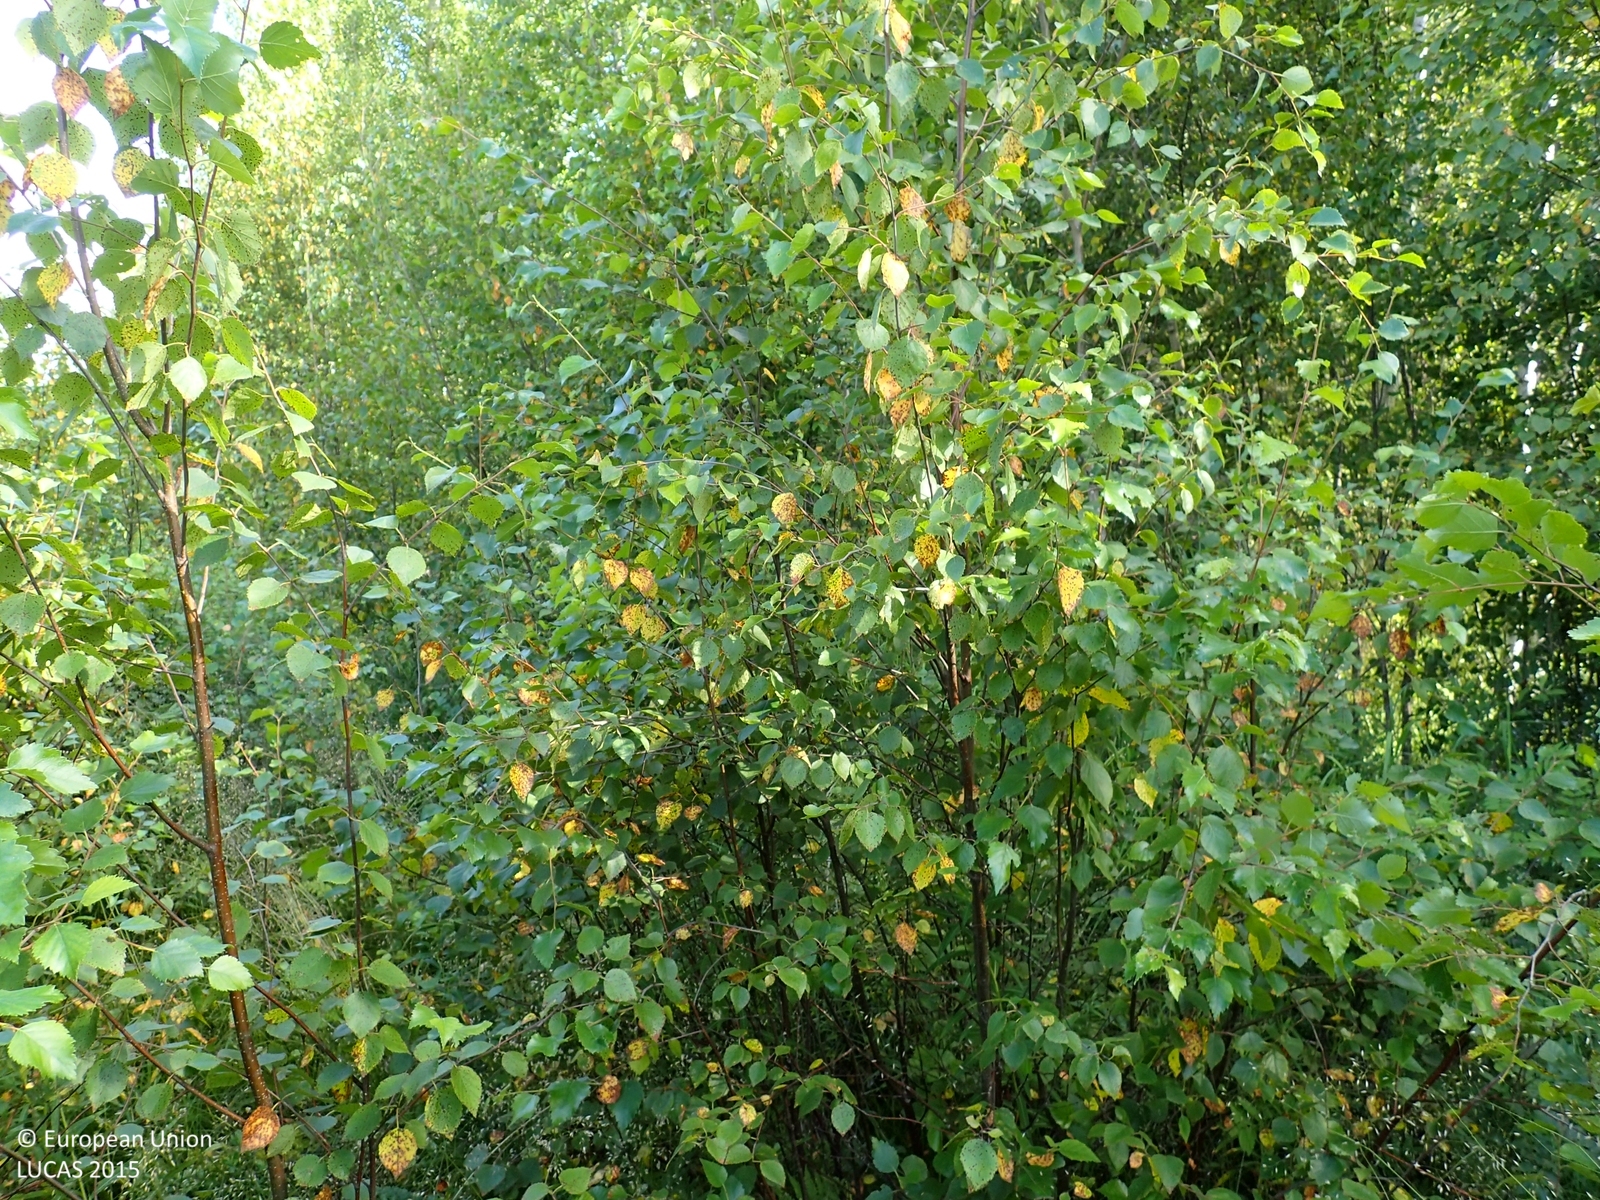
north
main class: Woodland
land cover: Broadleaved woodland
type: non-riverine alder, birch or aspen forest
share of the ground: > 75 %
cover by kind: broadleaved forest trees 90 %, herbaceous plants 10 %
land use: Forestry
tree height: < 5 m
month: August
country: FI
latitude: 62.7159
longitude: 21.9949
